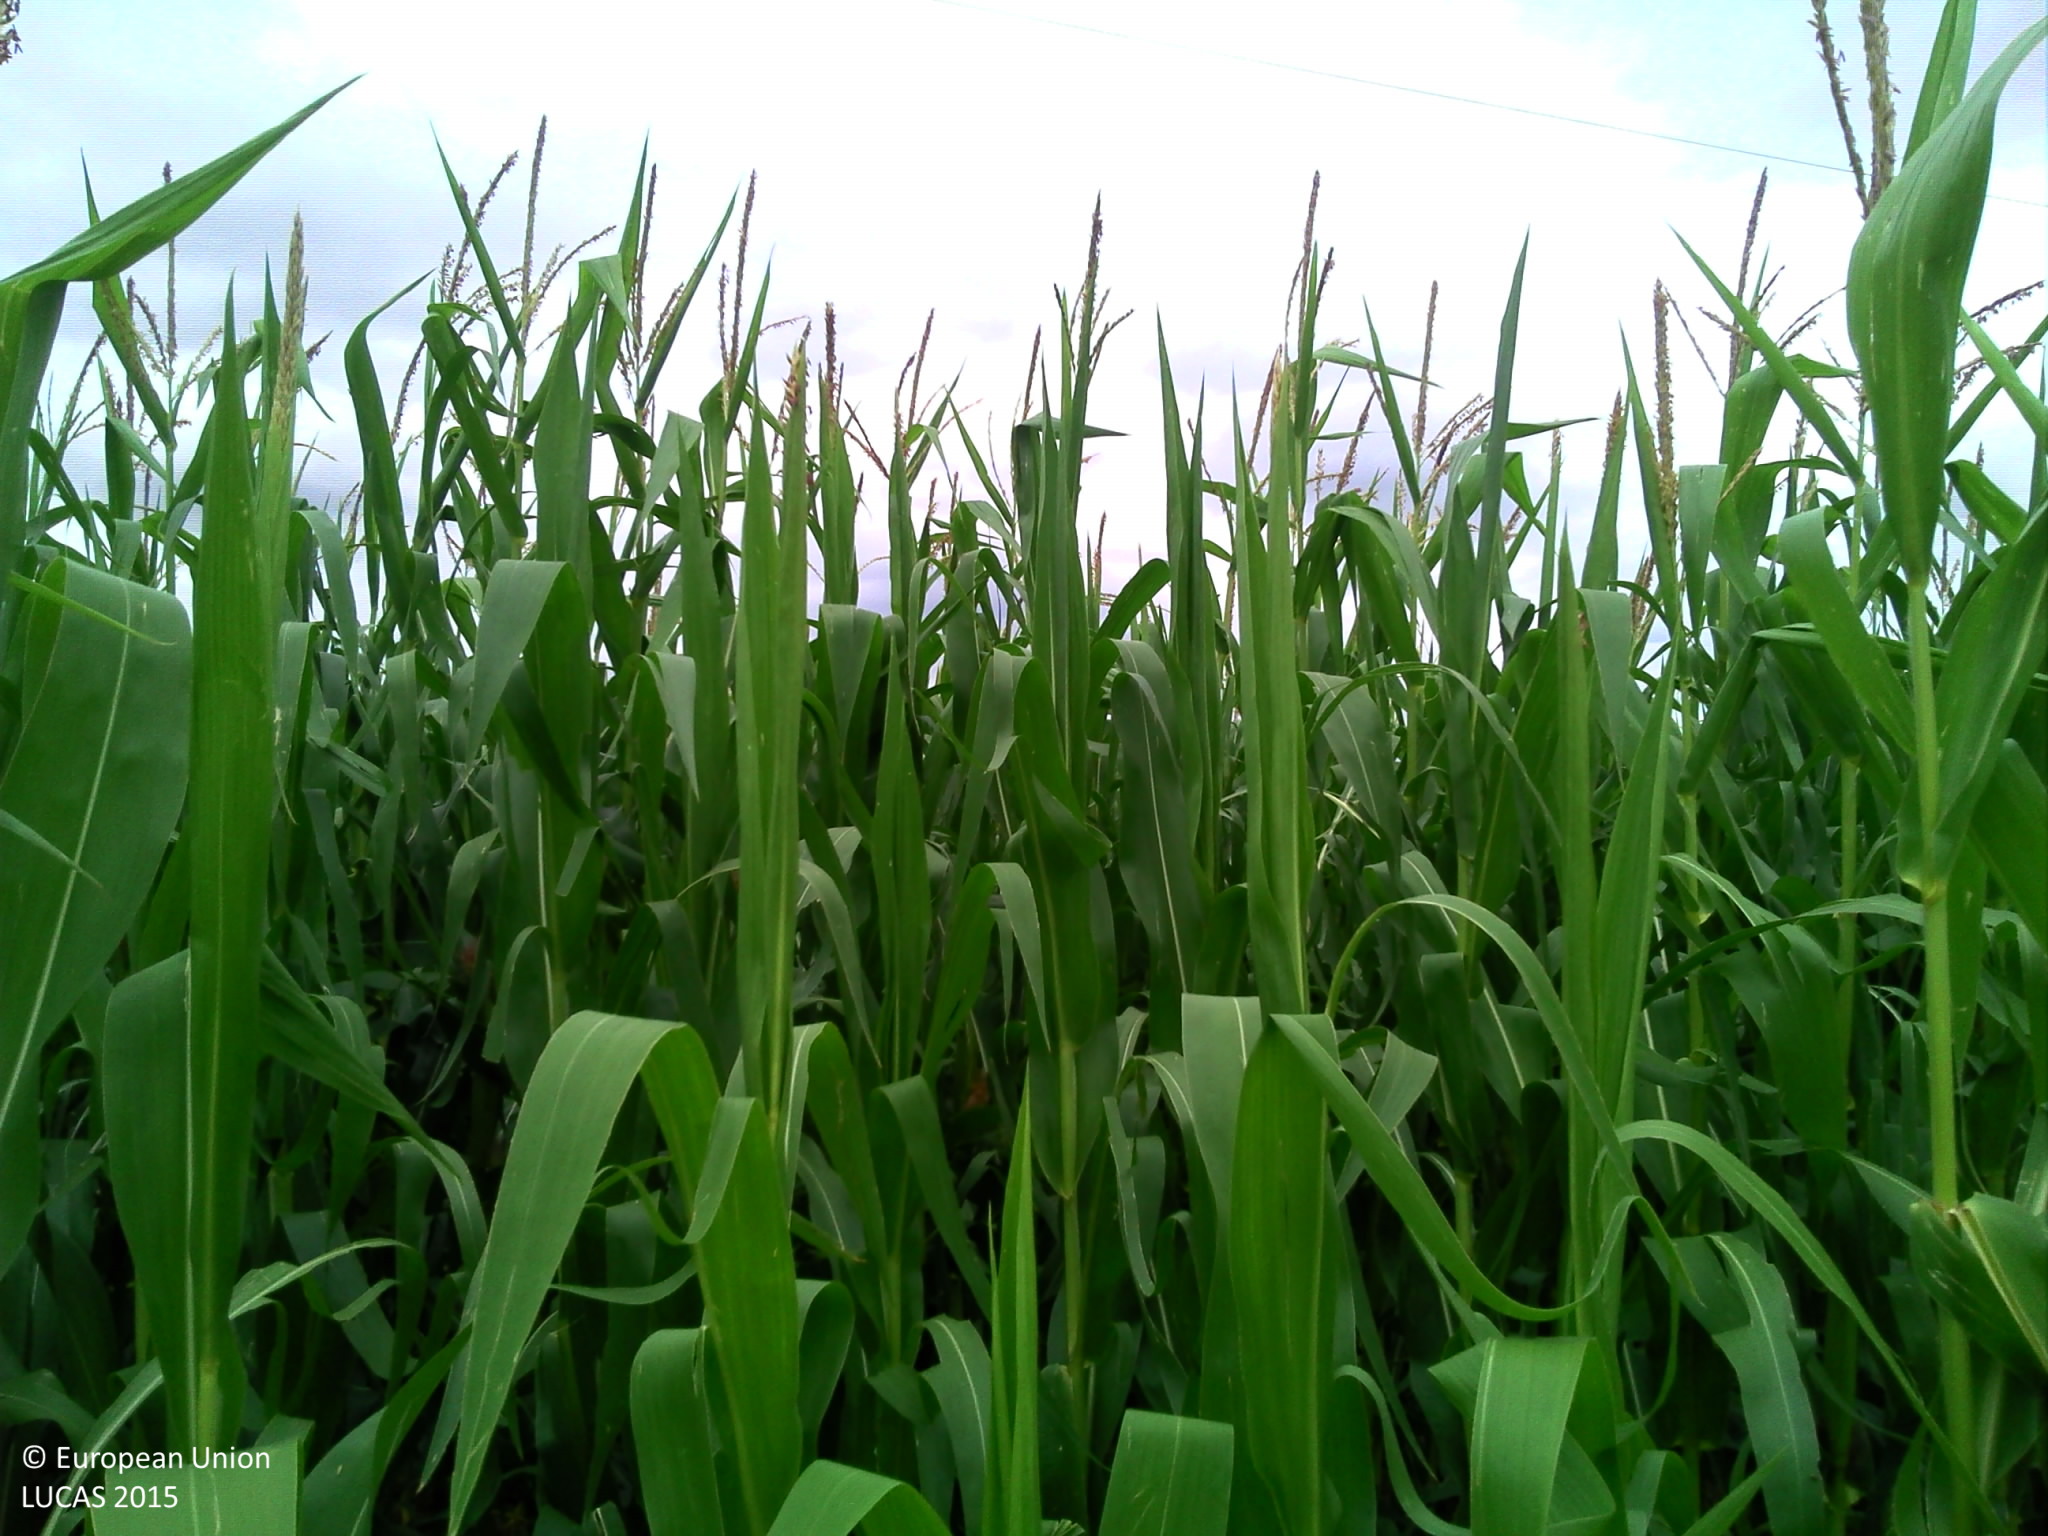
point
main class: Cropland
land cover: Maize
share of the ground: > 75 %
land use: Agriculture (excluding fallow land and kitchen gardens)
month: July
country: FR
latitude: 48.6474
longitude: 7.5983
